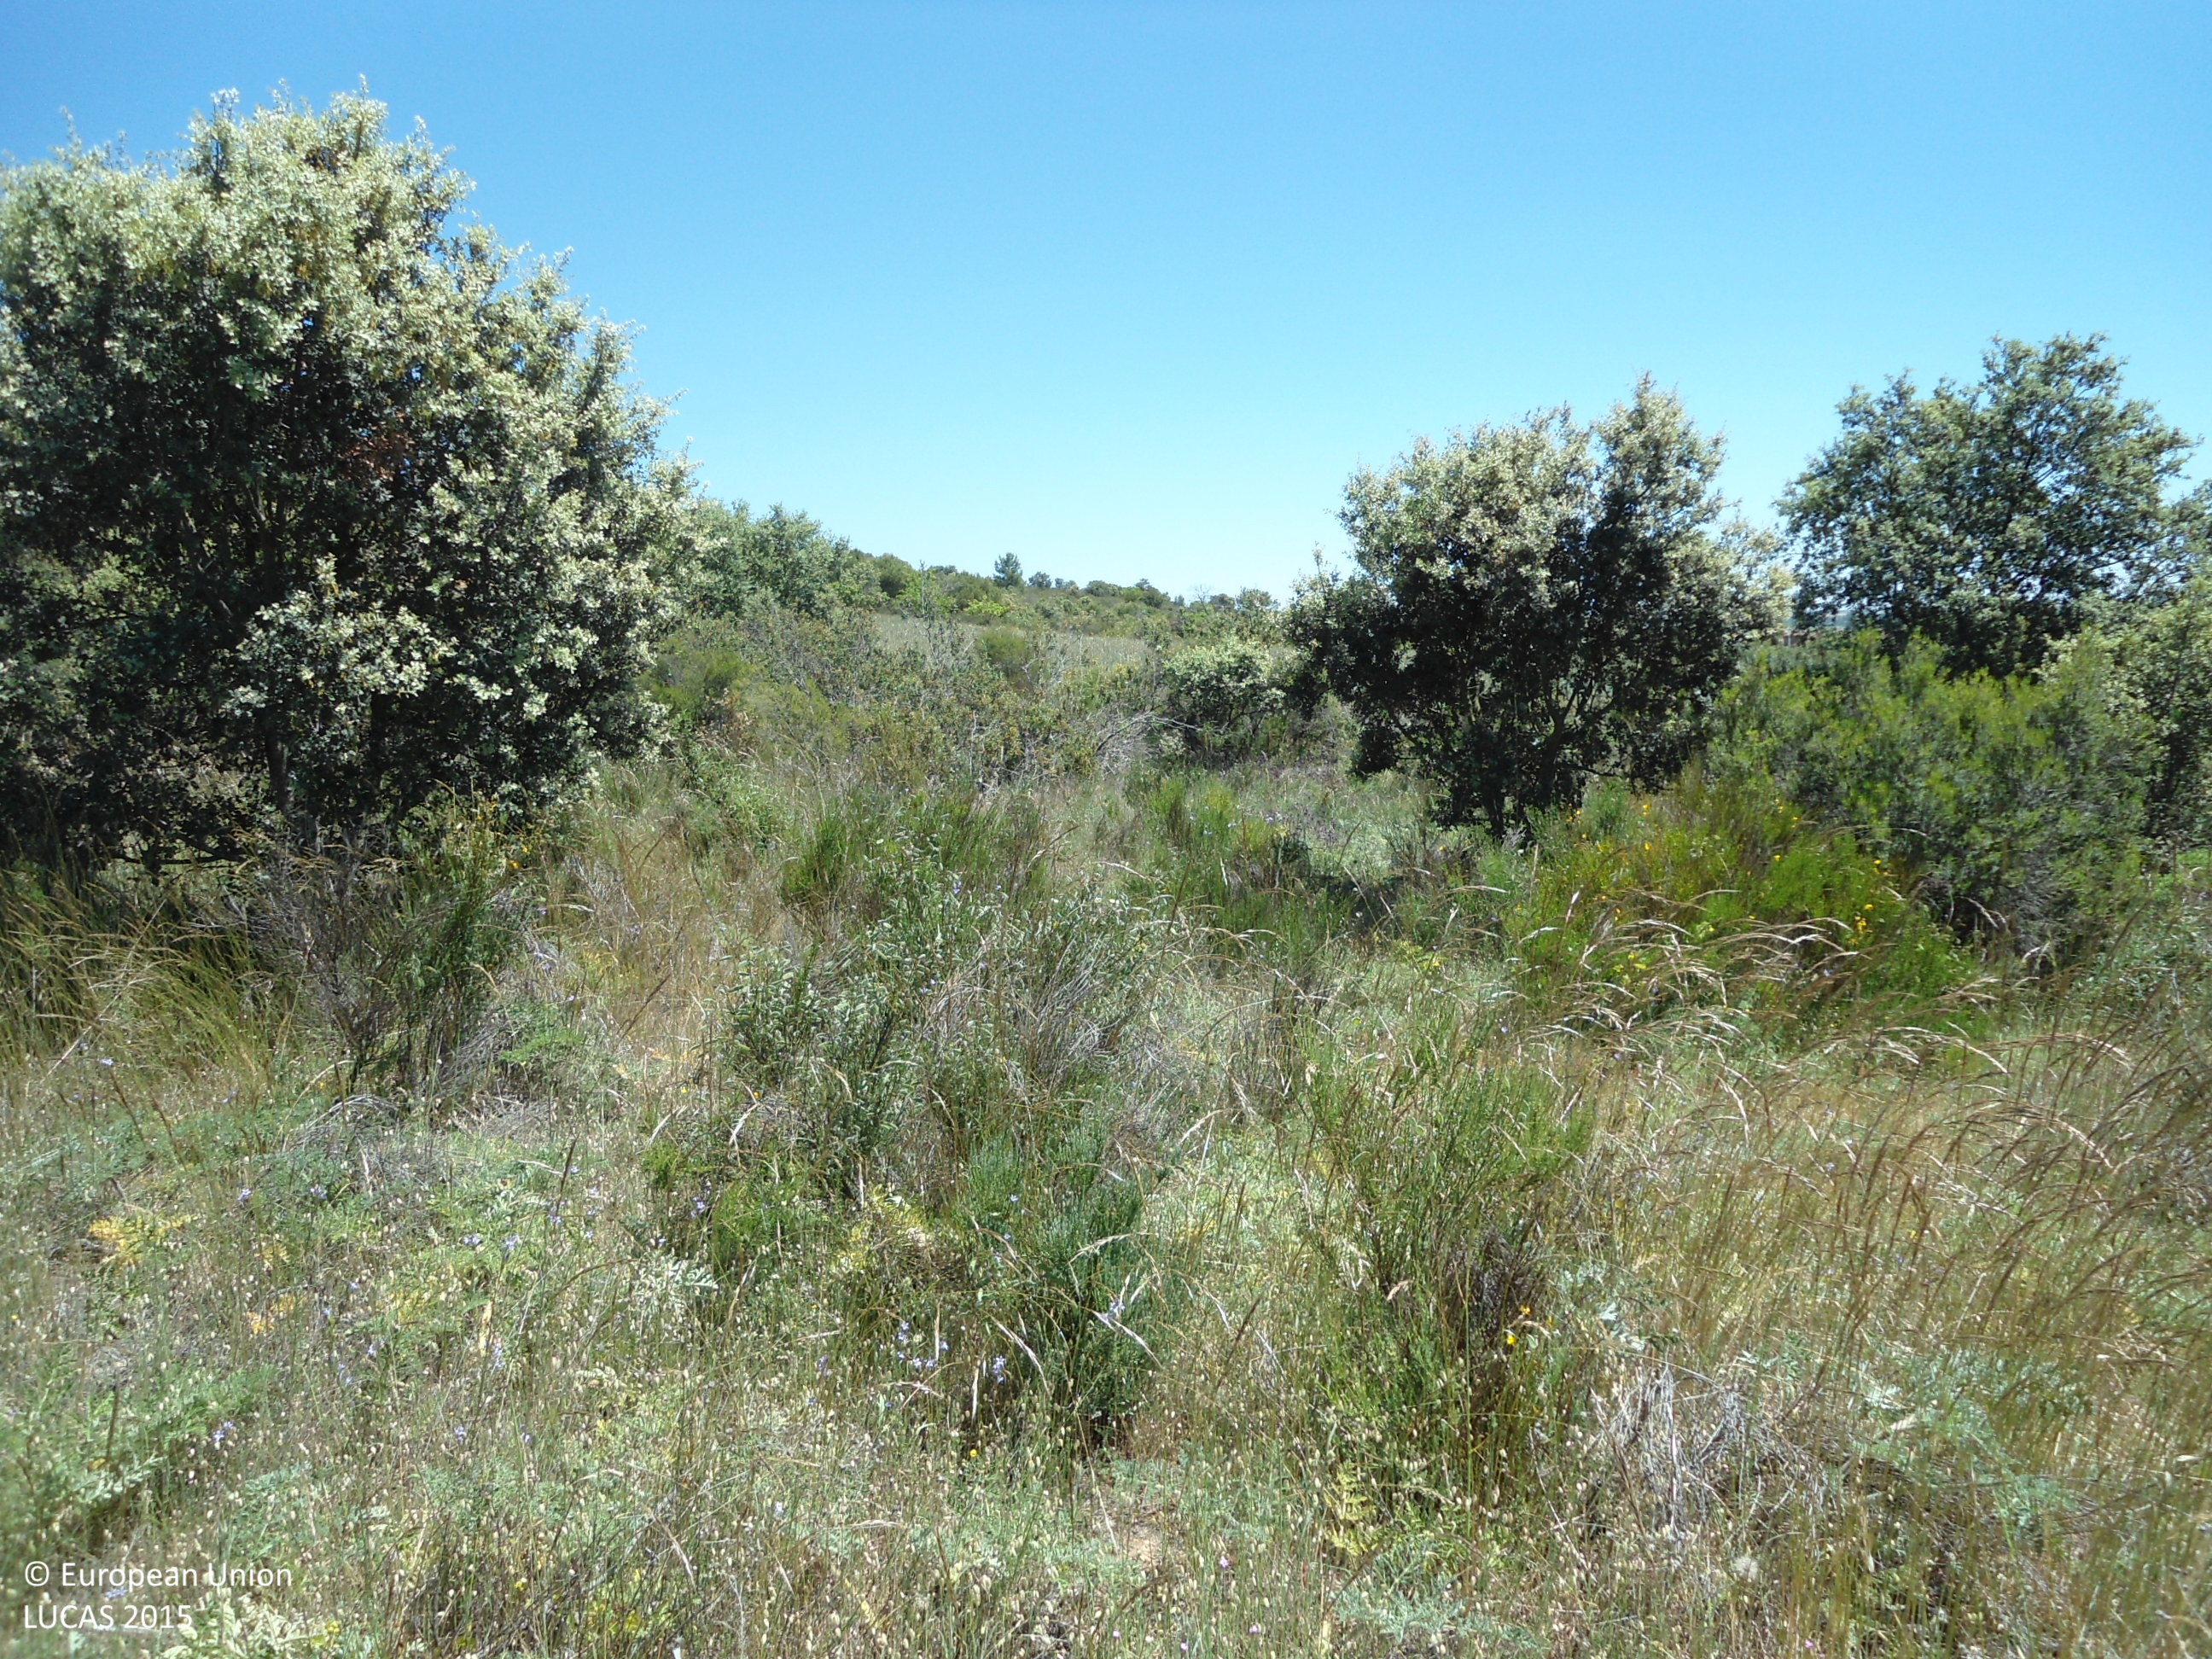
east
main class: Shrubland
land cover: Shrubland without tree cover
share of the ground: > 75 %
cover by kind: shrubs 80 %, herbaceous plants 20 %
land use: Semi-natural and natural areas not in use
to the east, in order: Shrubland without tree cover; Broadleaved woodland; Rye; Other bare soil; Other fruit trees and berries; Other bare soil; Shrubland with sparse tree cover; Other bare soil; Pine dominated coniferous woodland; Other bare soil; Shrubland without tree cover; Rock outcrops; Shrubland without tree cover; Shrubland with sparse tree cover
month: May
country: ES
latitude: 42.1033
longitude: -6.0262
